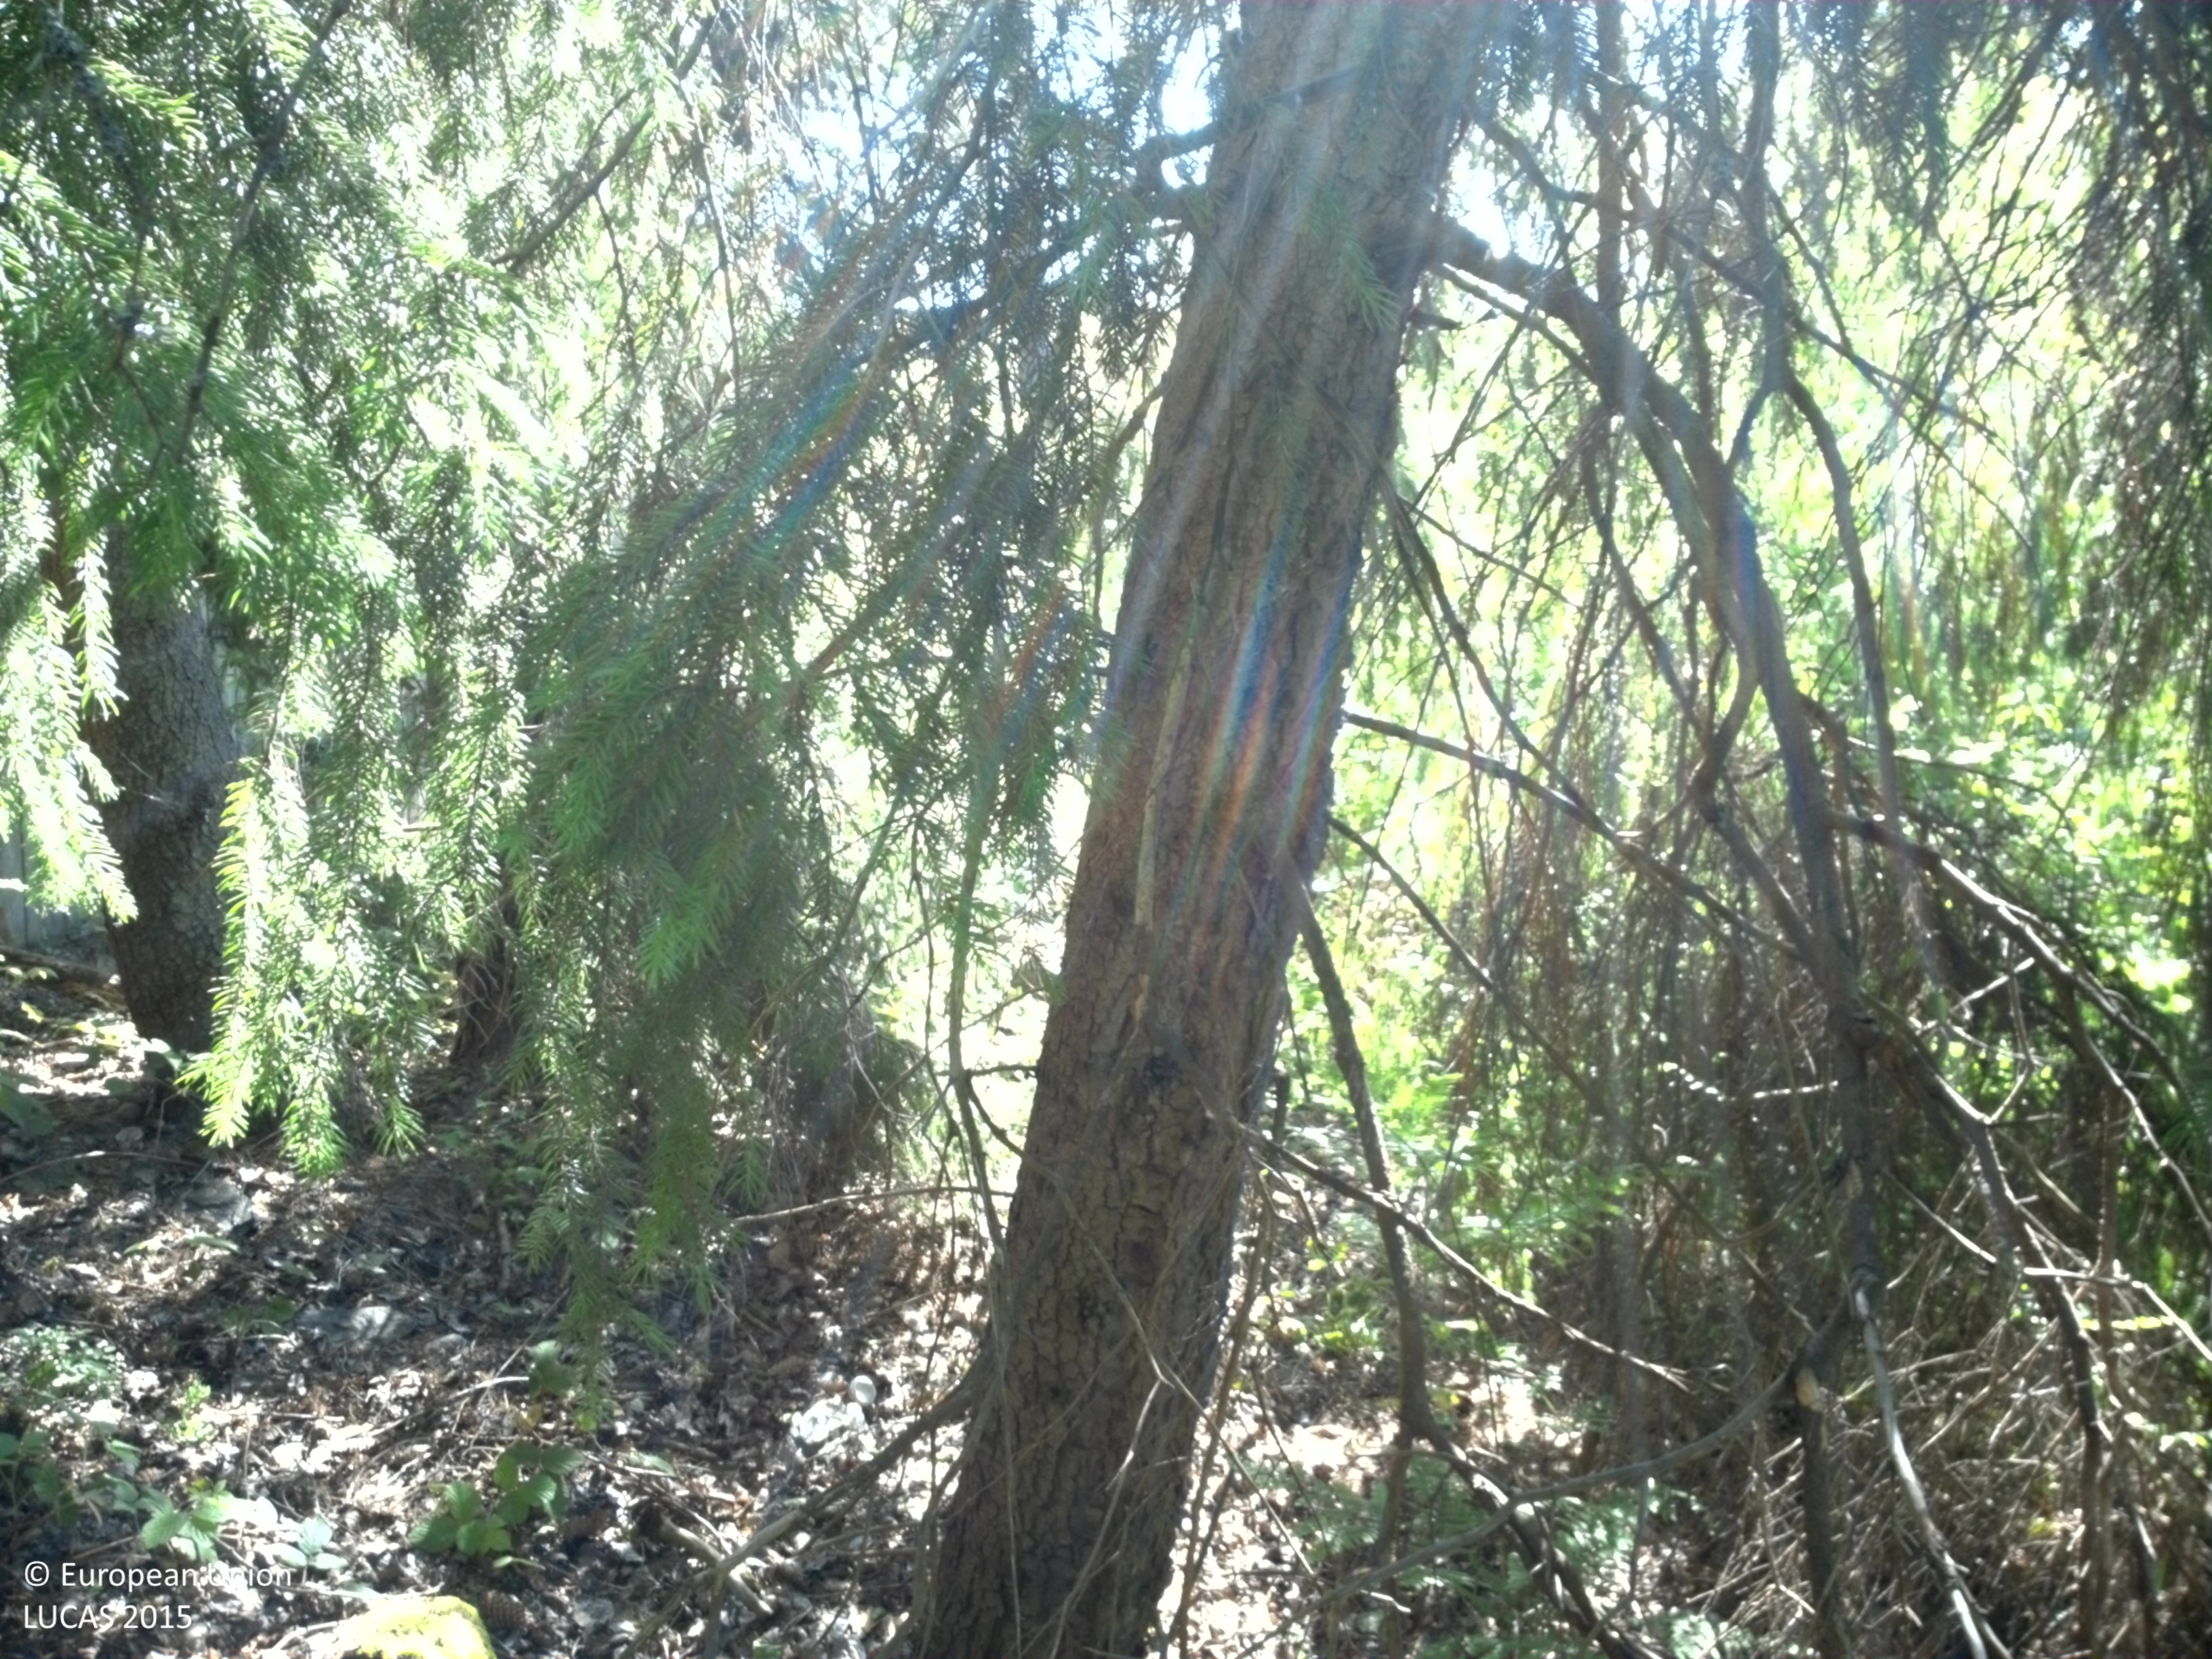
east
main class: Woodland
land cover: Spruce dominated mixed woodland
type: boreal forest
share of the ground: 50 - 75 %
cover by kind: coniferous forest trees 45 %, broadleaved forest trees 30 %, herbaceous plants 20 %, lichens and mosses 5 %
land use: Semi-natural and natural areas not in use
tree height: > 5 m
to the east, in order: Spruce dominated mixed woodland; Artificial constructions in urban areas; Pine dominated coniferous woodland; Spruce dominated mixed woodland
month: June
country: SE
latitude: 58.6600
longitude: 16.4596
